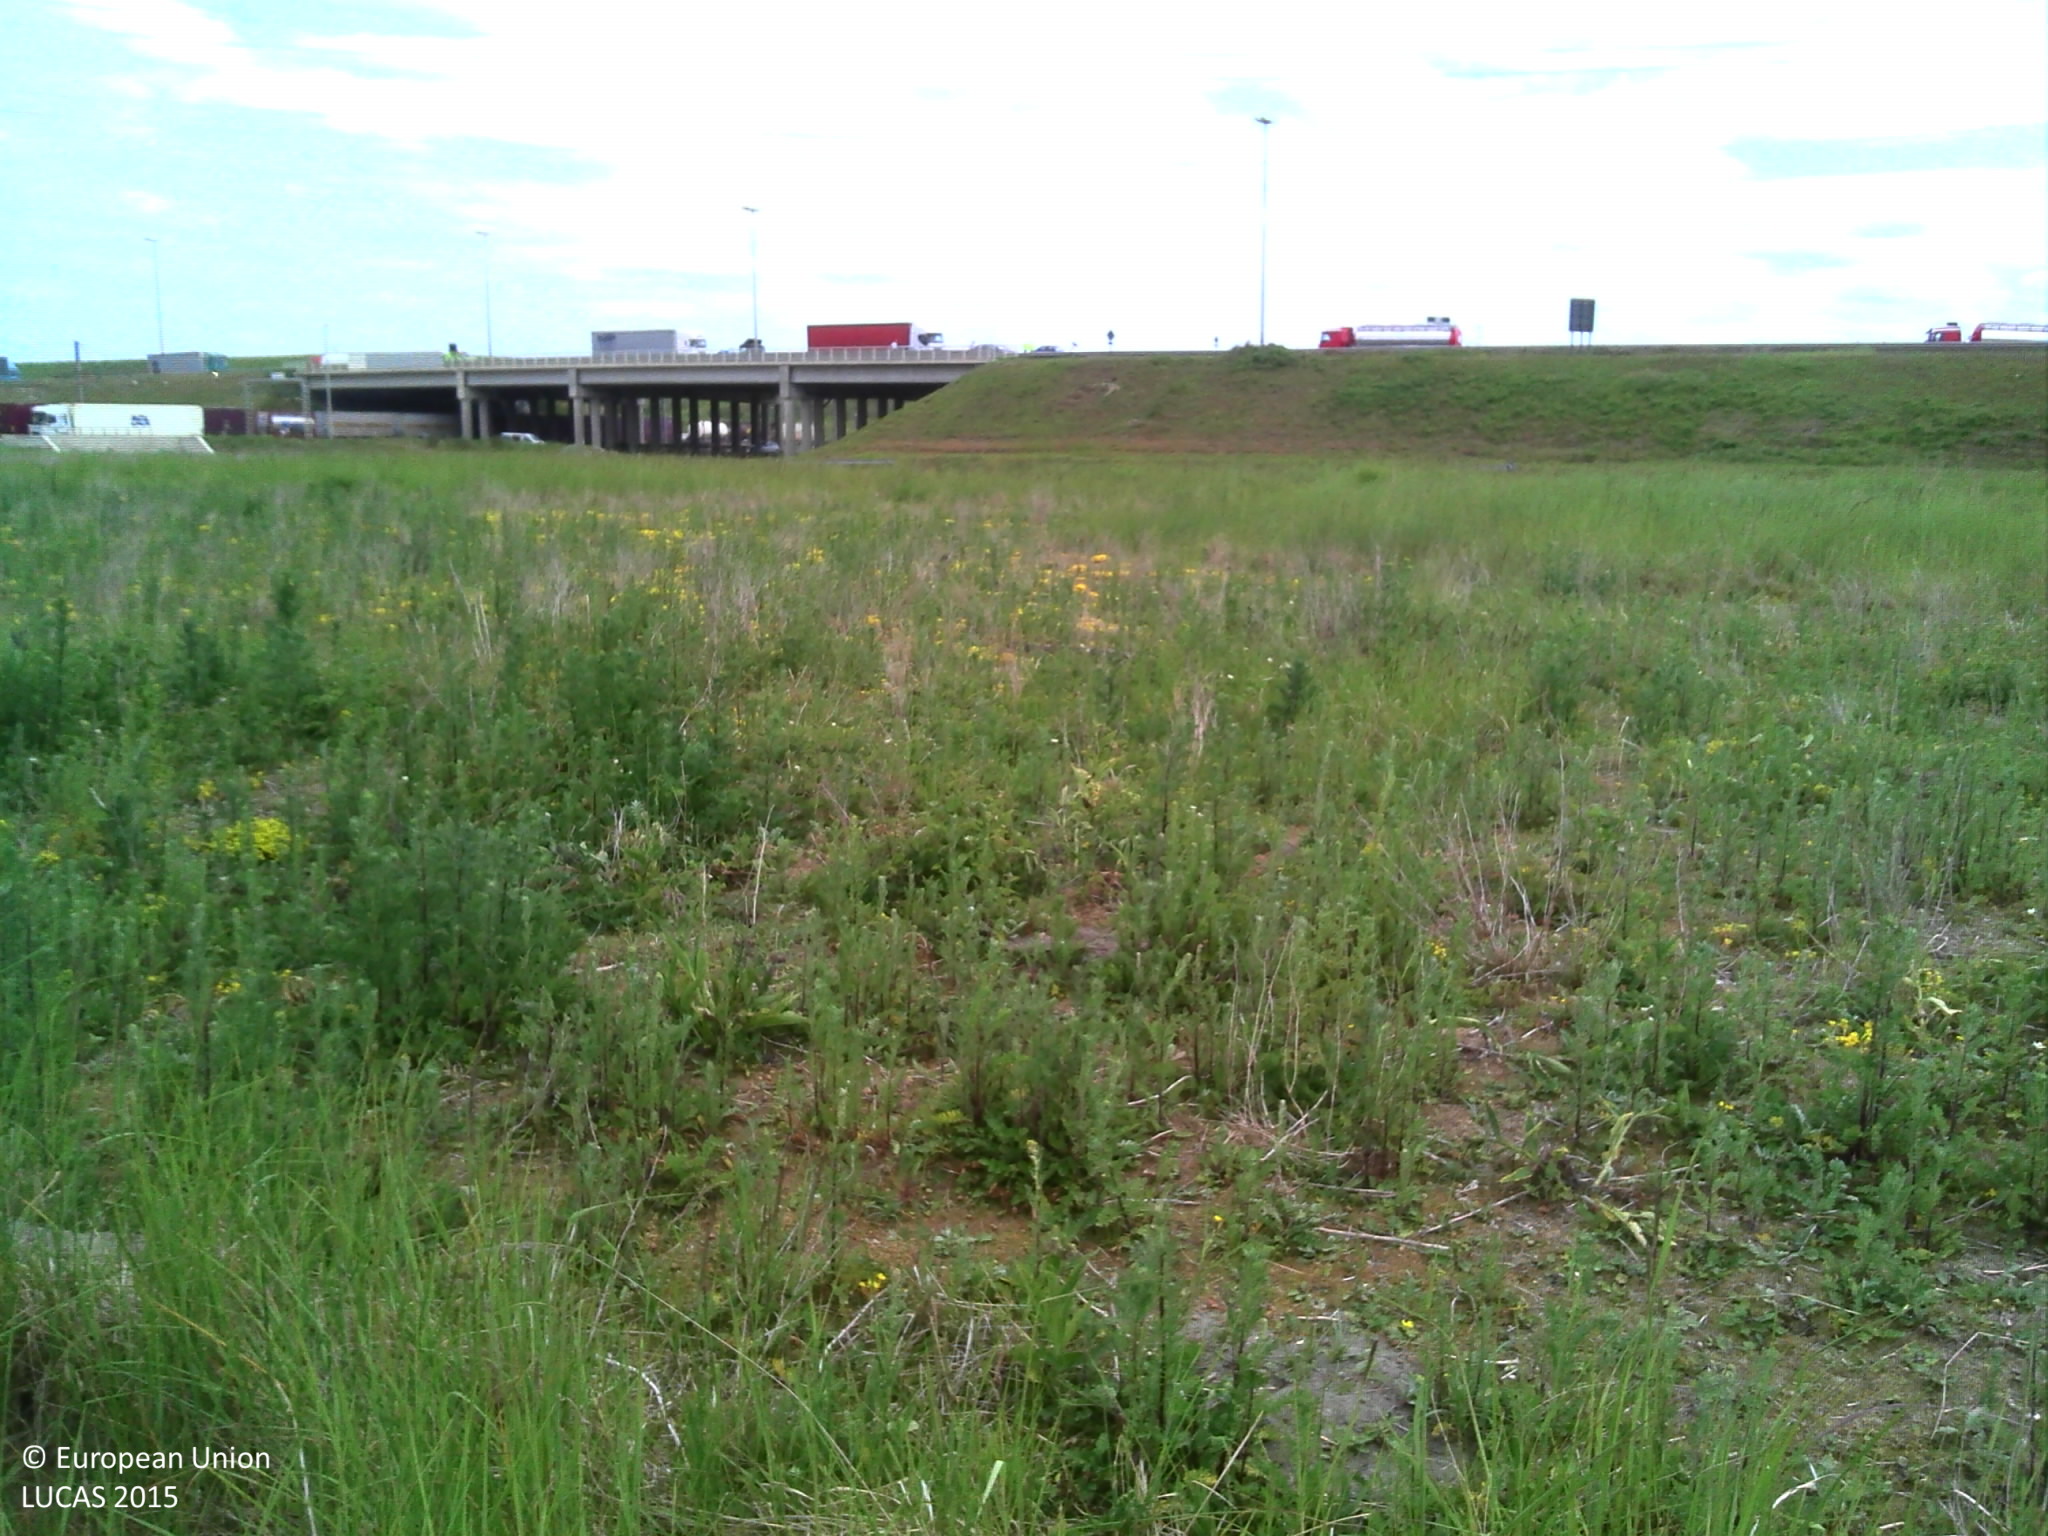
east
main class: Grassland
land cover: Grassland without tree/shrub cover
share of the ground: > 75 %
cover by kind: herbaceous plants 100 %
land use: Semi-natural and natural areas not in use
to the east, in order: Grassland without tree/shrub cover; Spontaneously vegetated surfaces; Ditches and canals; Grassland without tree/shrub cover; Electric lines; Railways; Electric lines; Ditches and canals; Grassland without tree/shrub cover; Paved roads, cycling and walking lanes; Grassland without tree/shrub cover; Paved roads, cycling and walking lanes
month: June
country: BE
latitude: 51.2469
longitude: 4.2502
